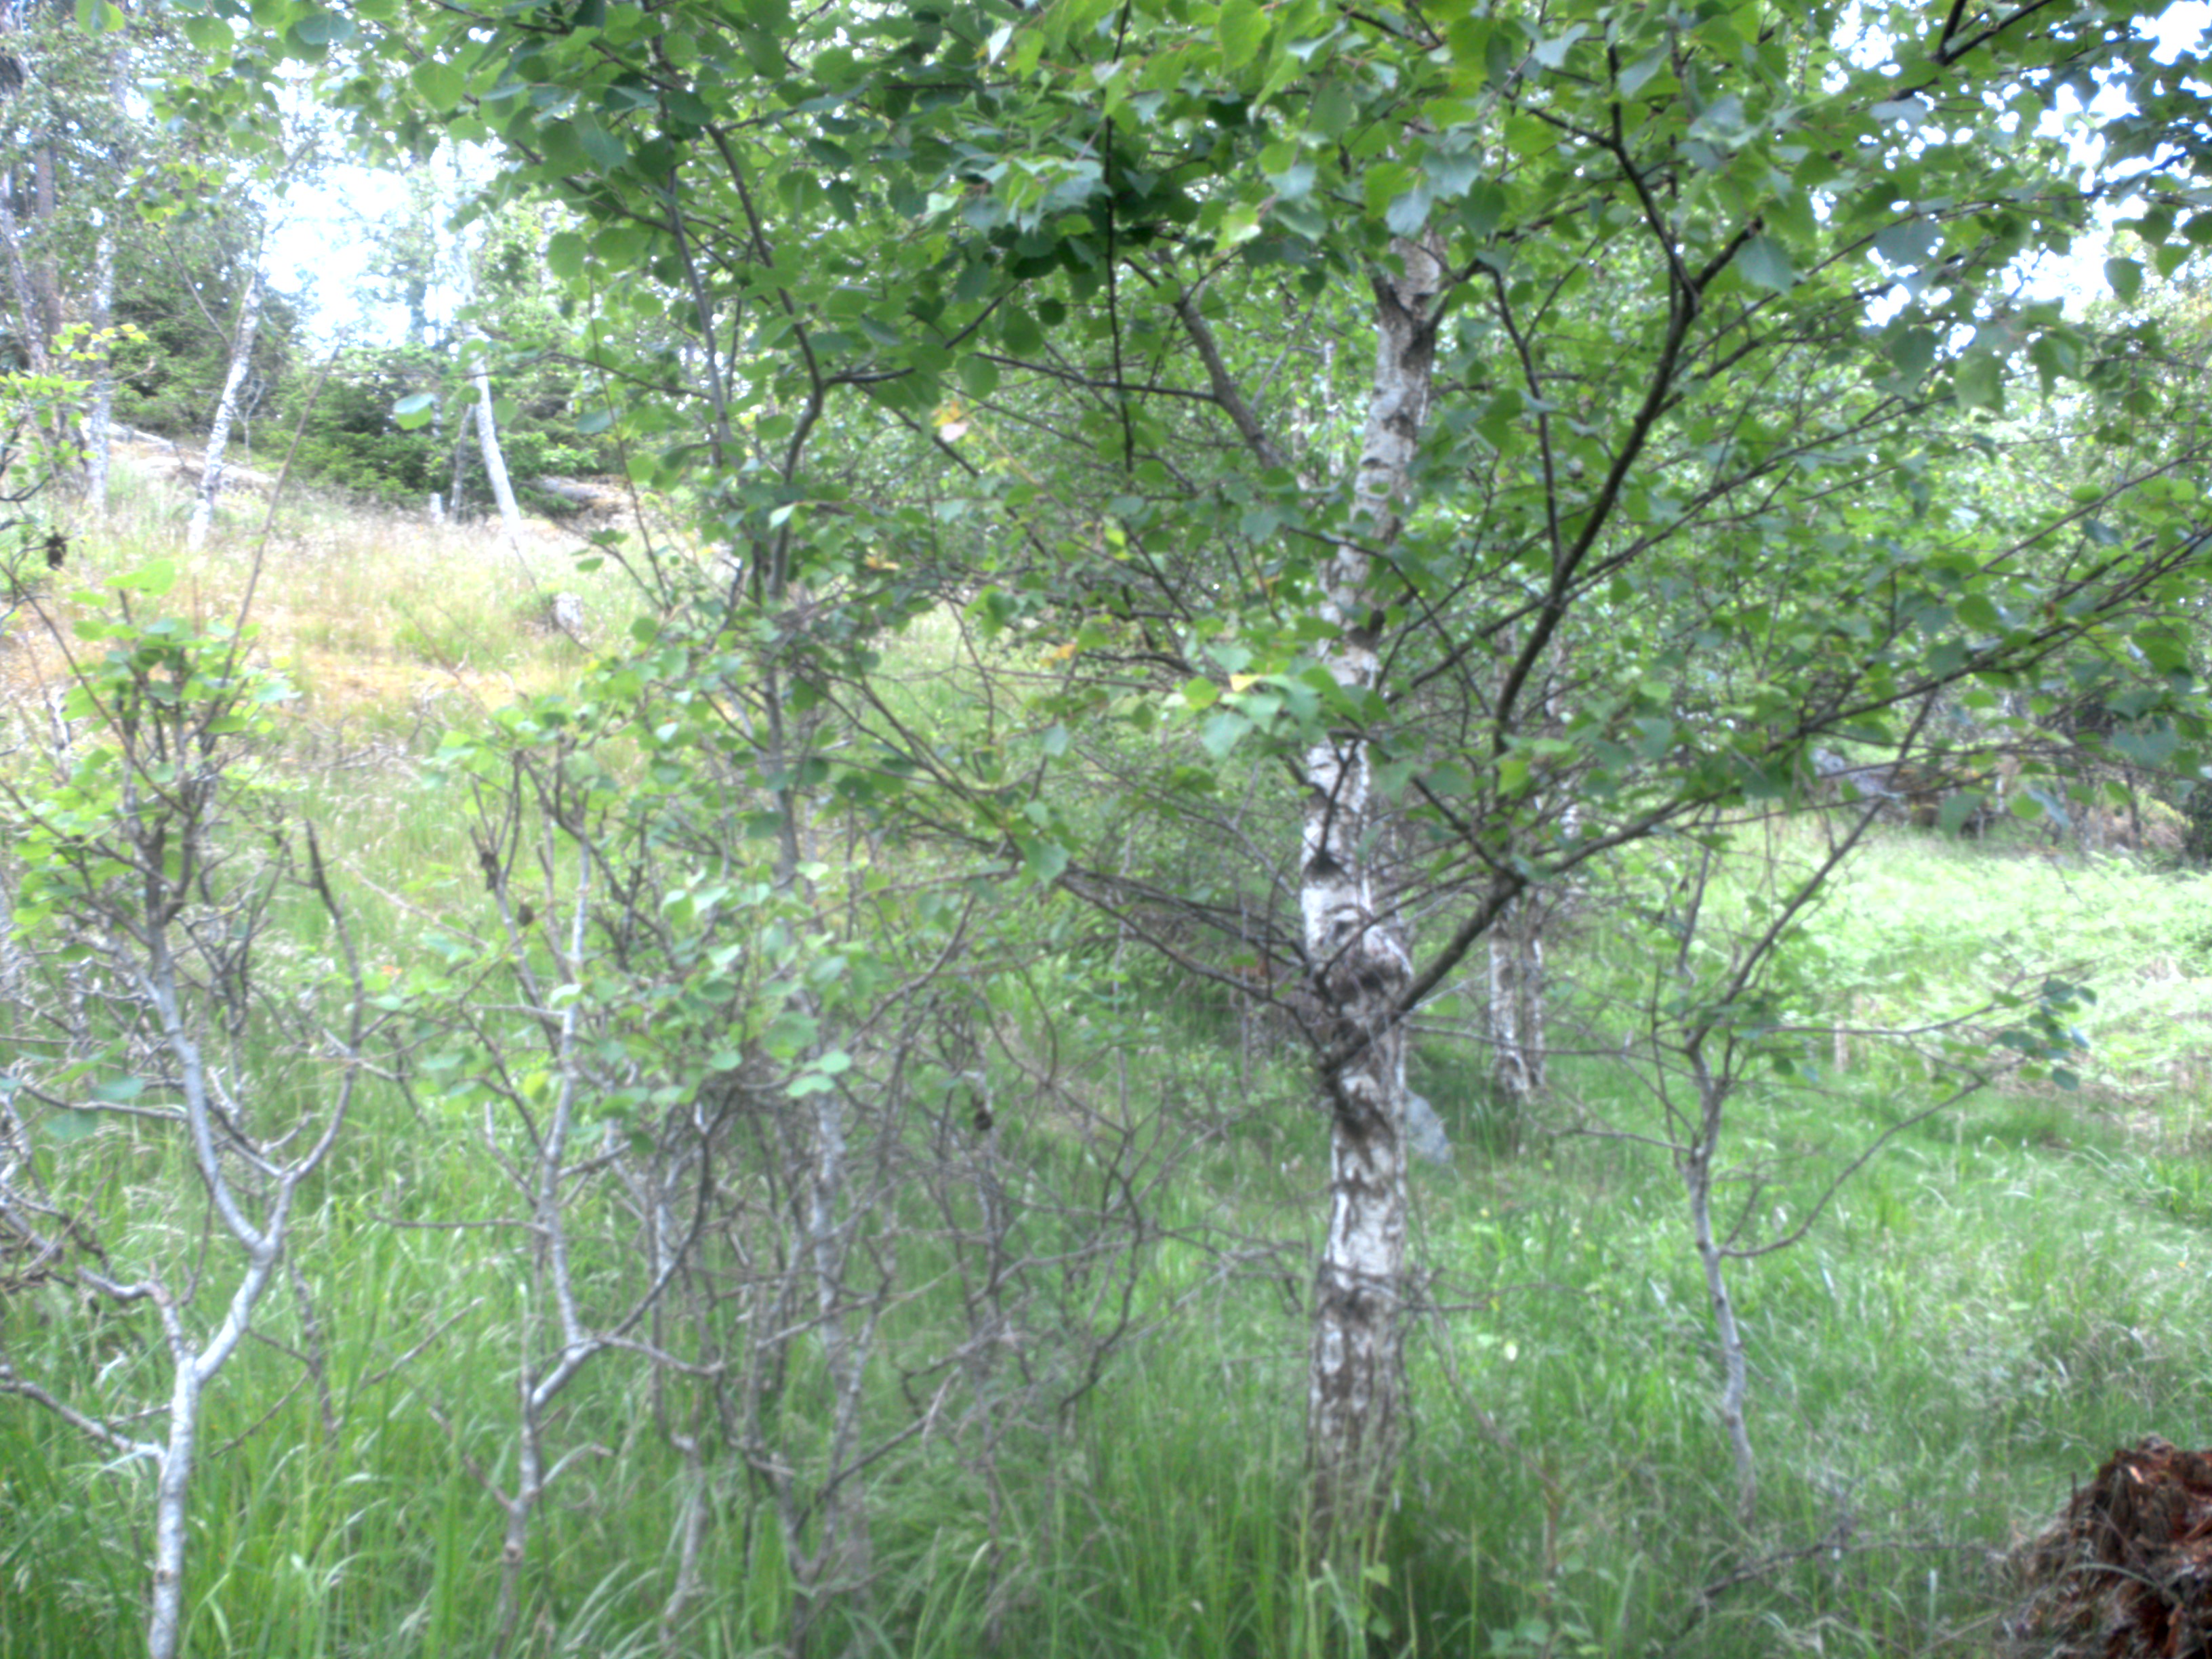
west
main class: Woodland
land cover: Broadleaved woodland
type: hemiboreal forest and nemoral coniferous forest and mixed broadleaved-coniferous forest
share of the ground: 10 - 25 %
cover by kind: herbaceous plants 80 %, broadleaved forest trees 20 %
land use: Semi-natural and natural areas not in use
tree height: > 5 m
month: June
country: SE
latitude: 59.2487
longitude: 17.6596
